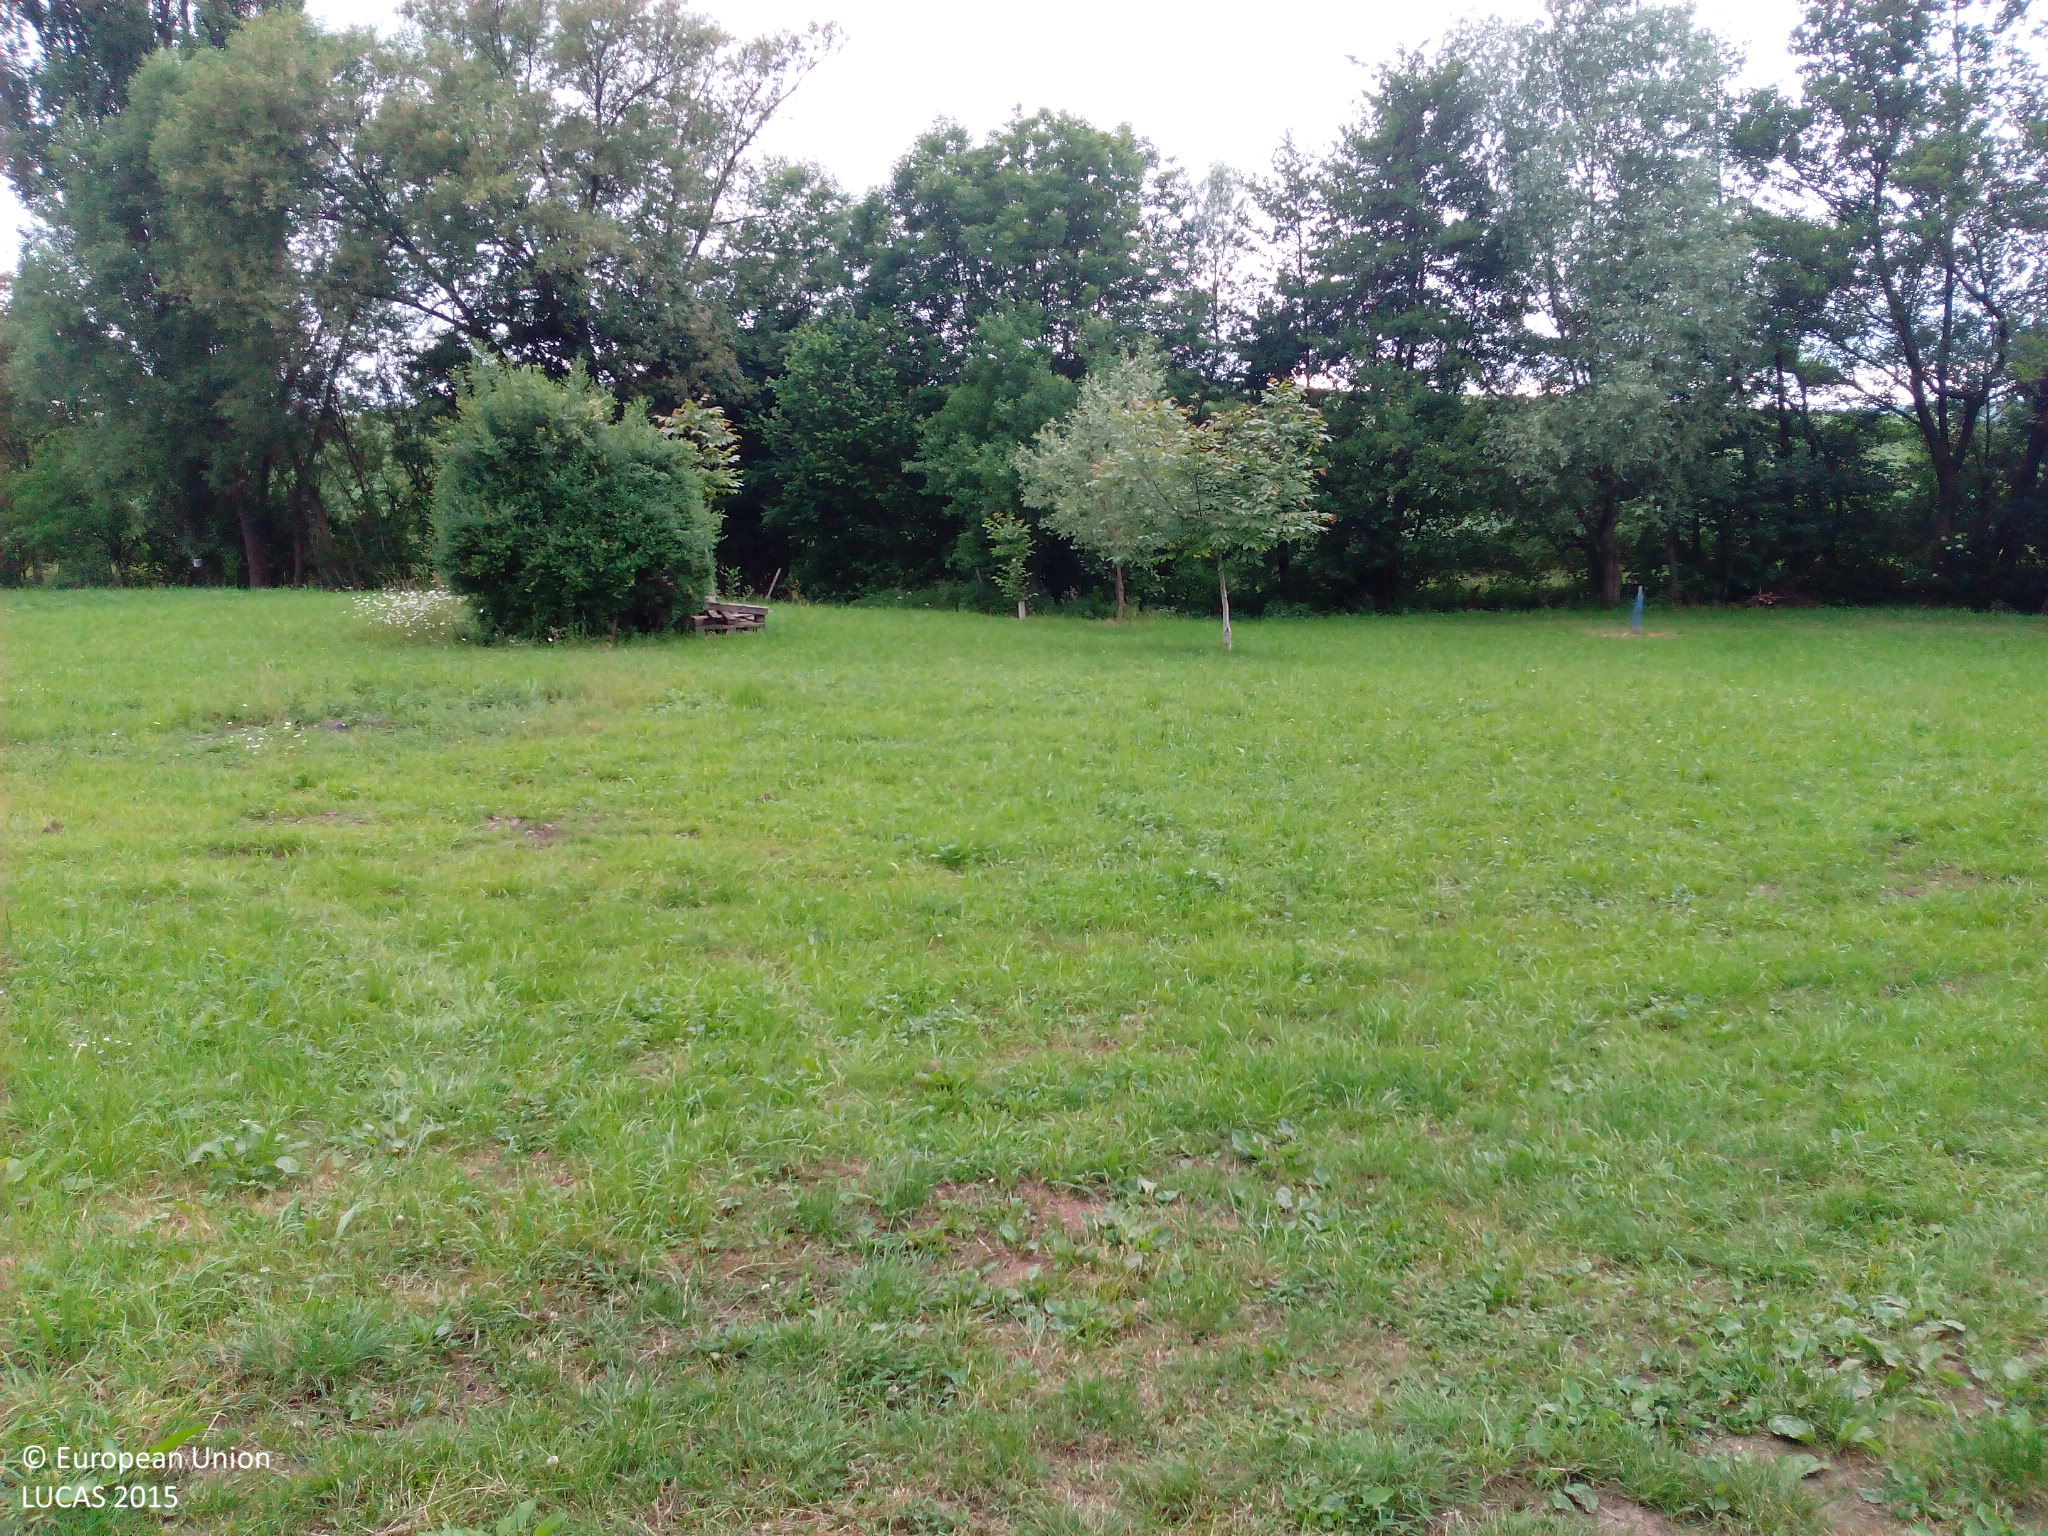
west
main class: Grassland
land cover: Grassland without tree/shrub cover
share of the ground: > 75 %
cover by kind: herbaceous plants 100 %
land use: Agriculture (excluding fallow land and kitchen gardens)
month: June
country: DE
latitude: 49.1216
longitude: 9.4111
